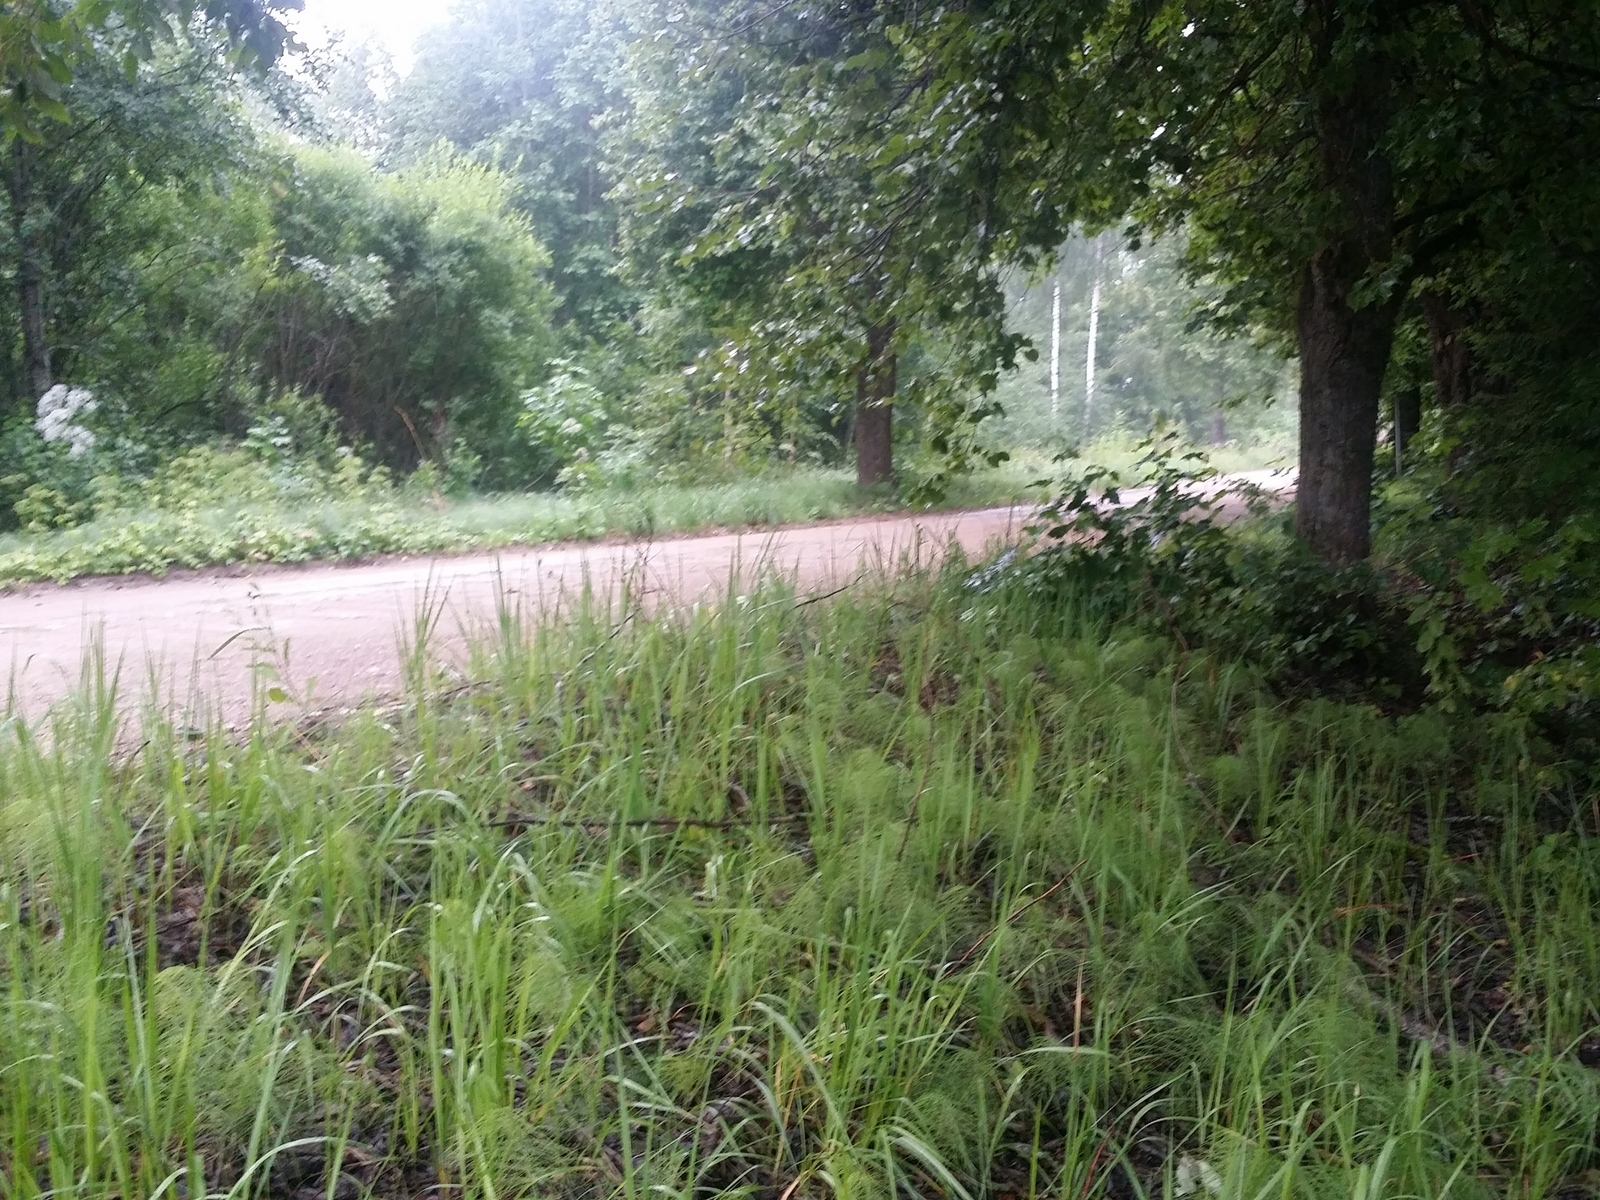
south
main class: Grassland
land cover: Spontaneously vegetated surfaces
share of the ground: > 75 %
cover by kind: herbaceous plants 100 %
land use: Agriculture (excluding fallow land and kitchen gardens)
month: July
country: LV
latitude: 57.1883
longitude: 26.6454
